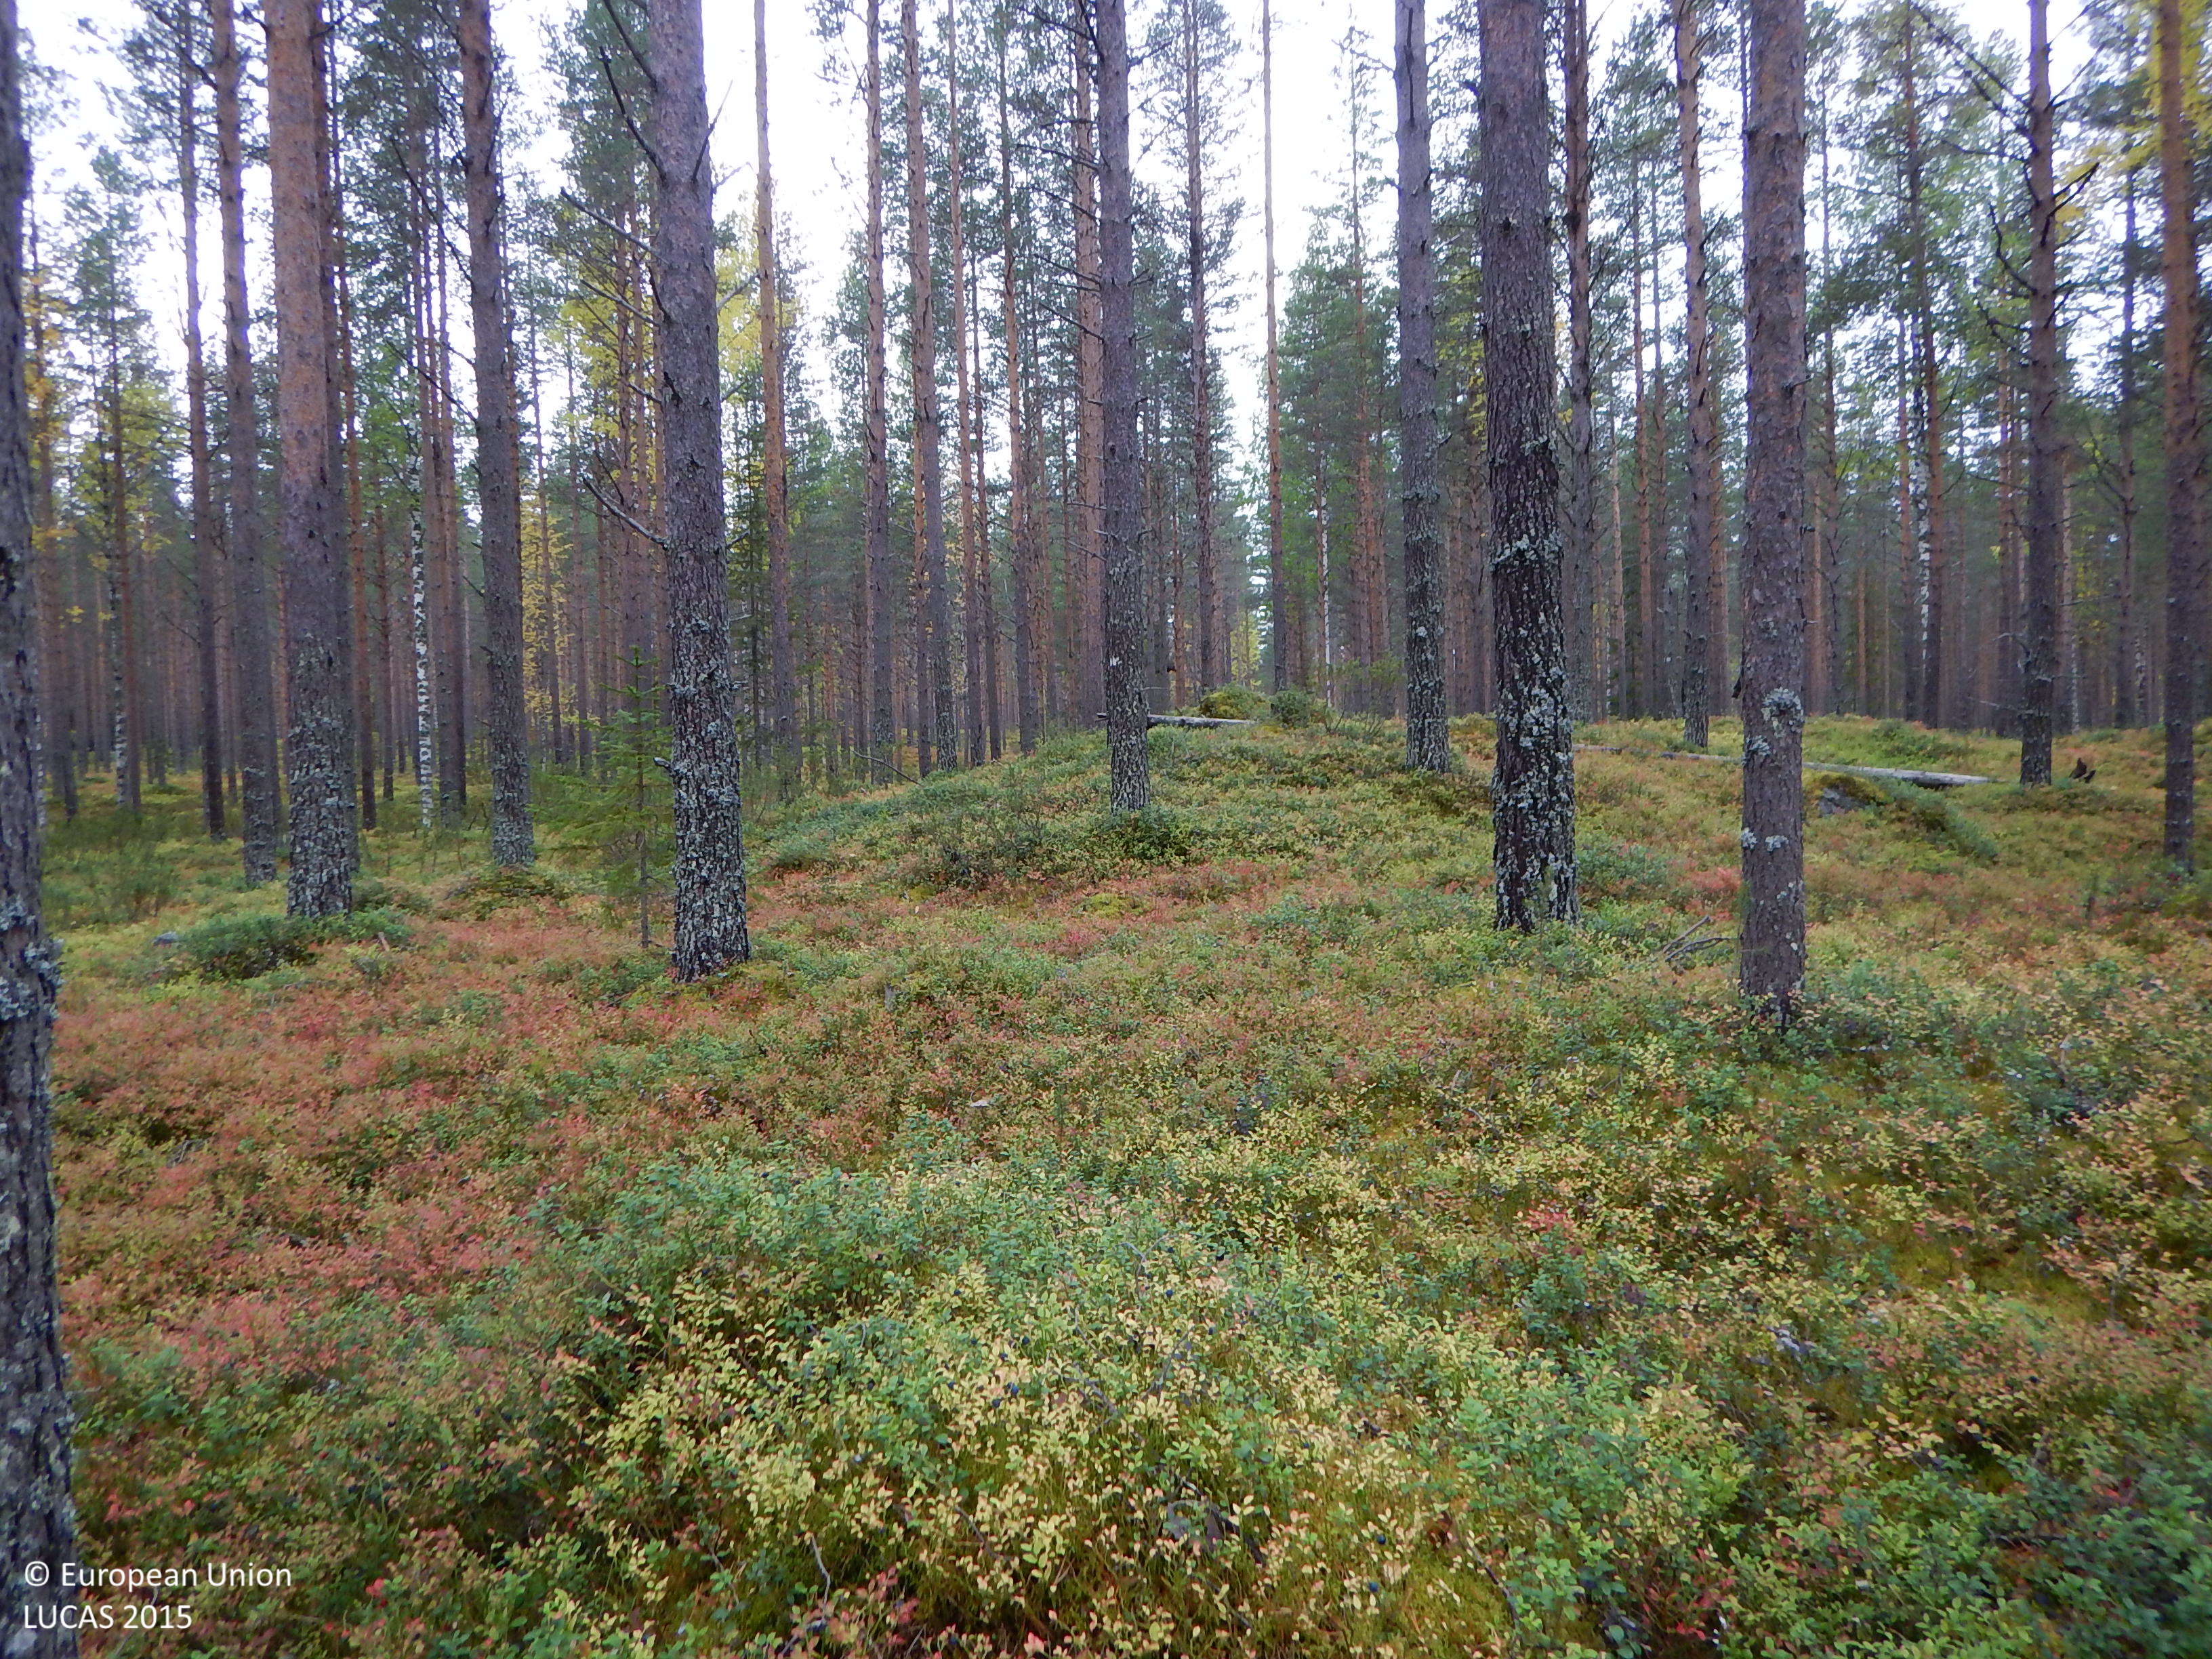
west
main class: Woodland
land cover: Pine dominated coniferous woodland
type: boreal forest
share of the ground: 50 - 75 %
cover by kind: coniferous forest trees 60 %, shrubs 20 %, lichens and mosses 15 %, broadleaved forest trees 5 %
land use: Forestry
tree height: > 5 m
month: September
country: SE
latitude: 65.1374
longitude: 19.1091
